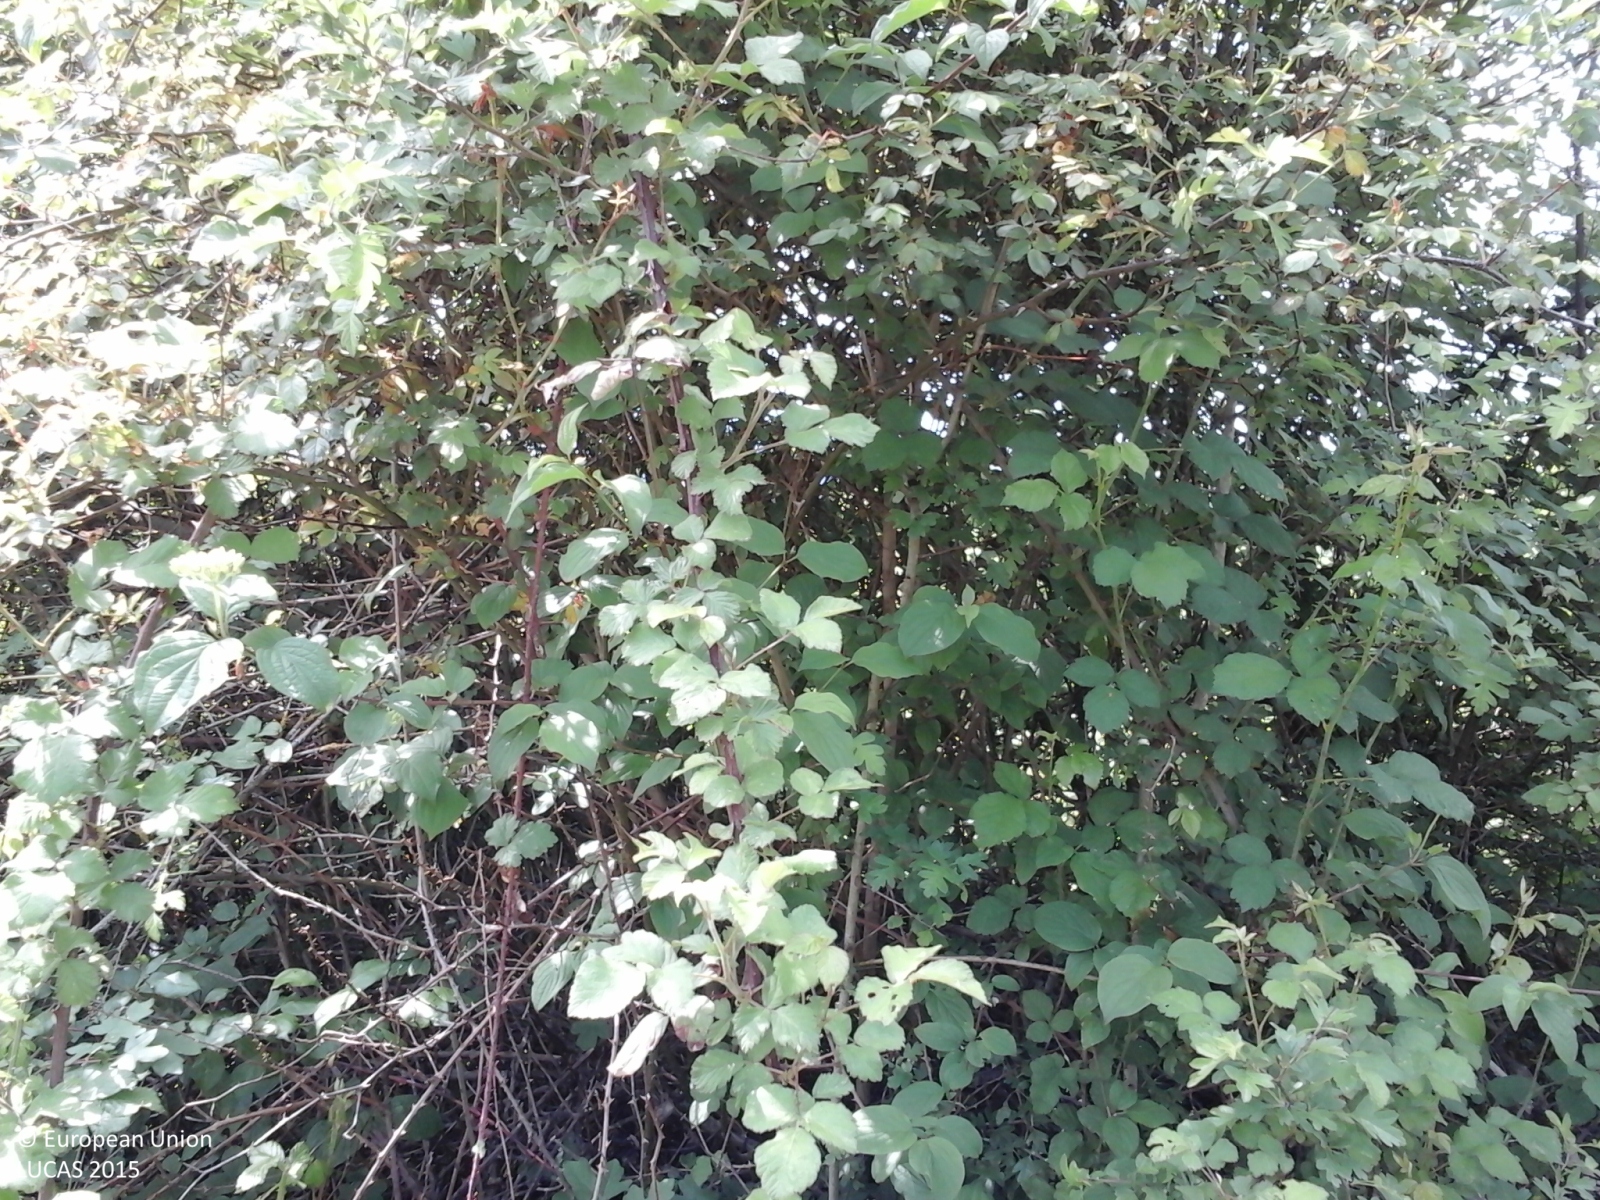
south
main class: Shrubland
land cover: Shrubland with sparse tree cover
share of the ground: 50 - 75 %
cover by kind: shrubs 90 %, broadleaved forest trees 5 %, herbaceous plants 5 %
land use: Forestry
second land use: Agriculture (excluding fallow land and kitchen gardens)
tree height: < 5 m
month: May
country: IT
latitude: 41.8628
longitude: 13.1809
